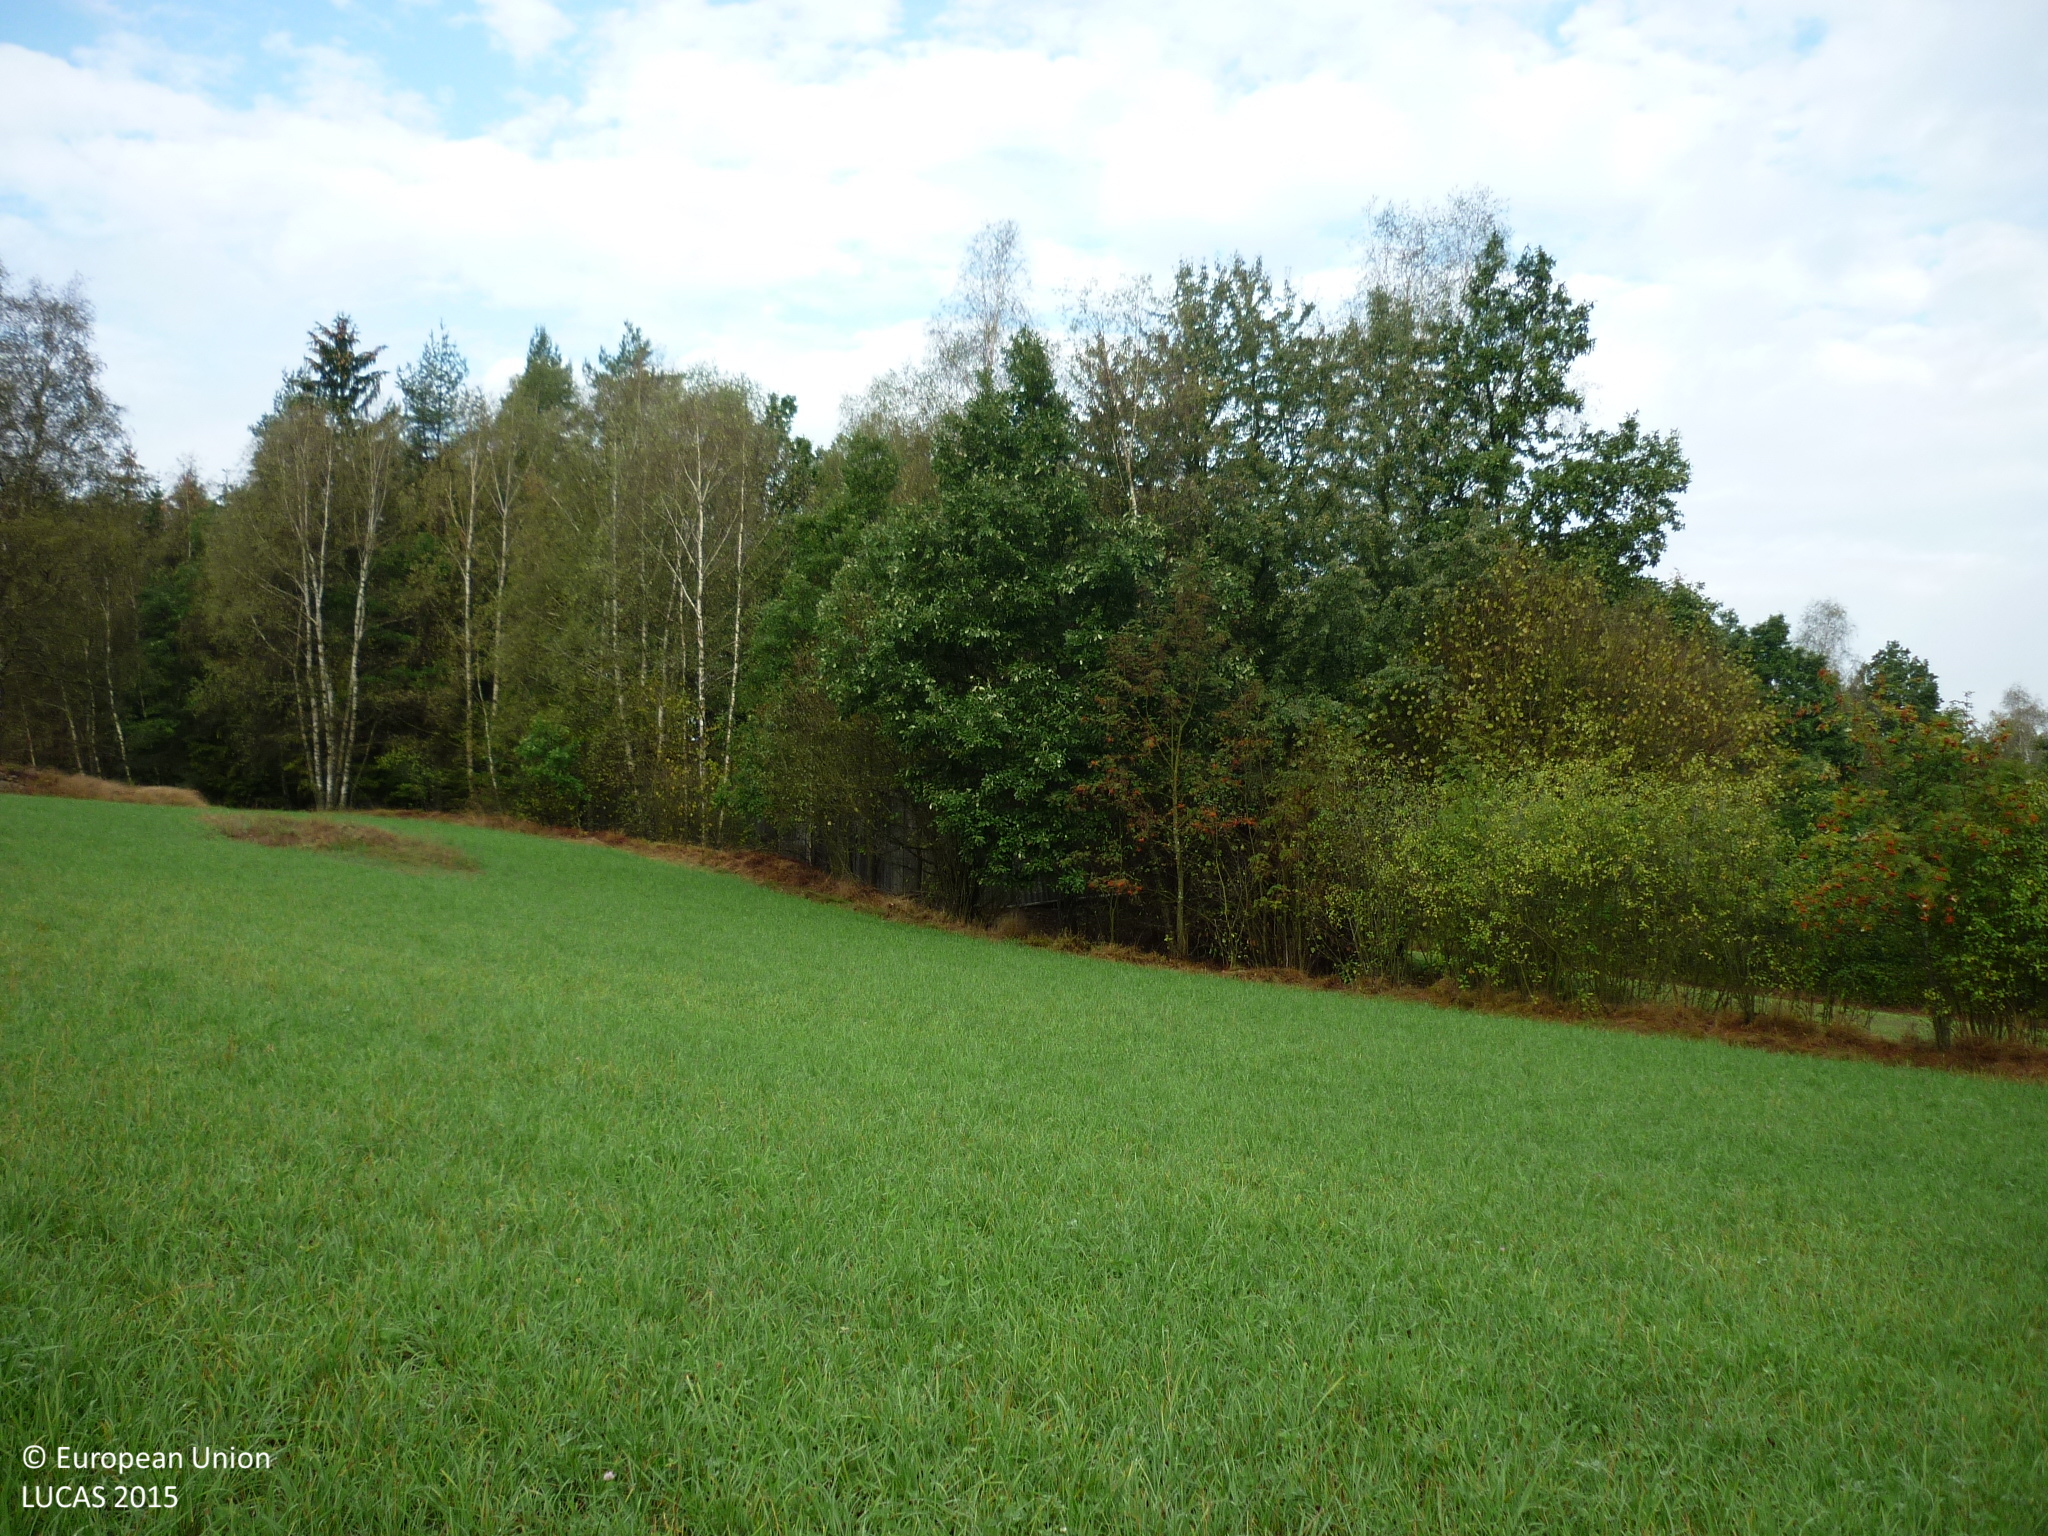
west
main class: Cropland
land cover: Other leguminous and mixtures for fodder
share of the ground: > 75 %
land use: Agriculture (excluding fallow land and kitchen gardens)
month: September
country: AT
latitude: 48.9567
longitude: 15.0142
